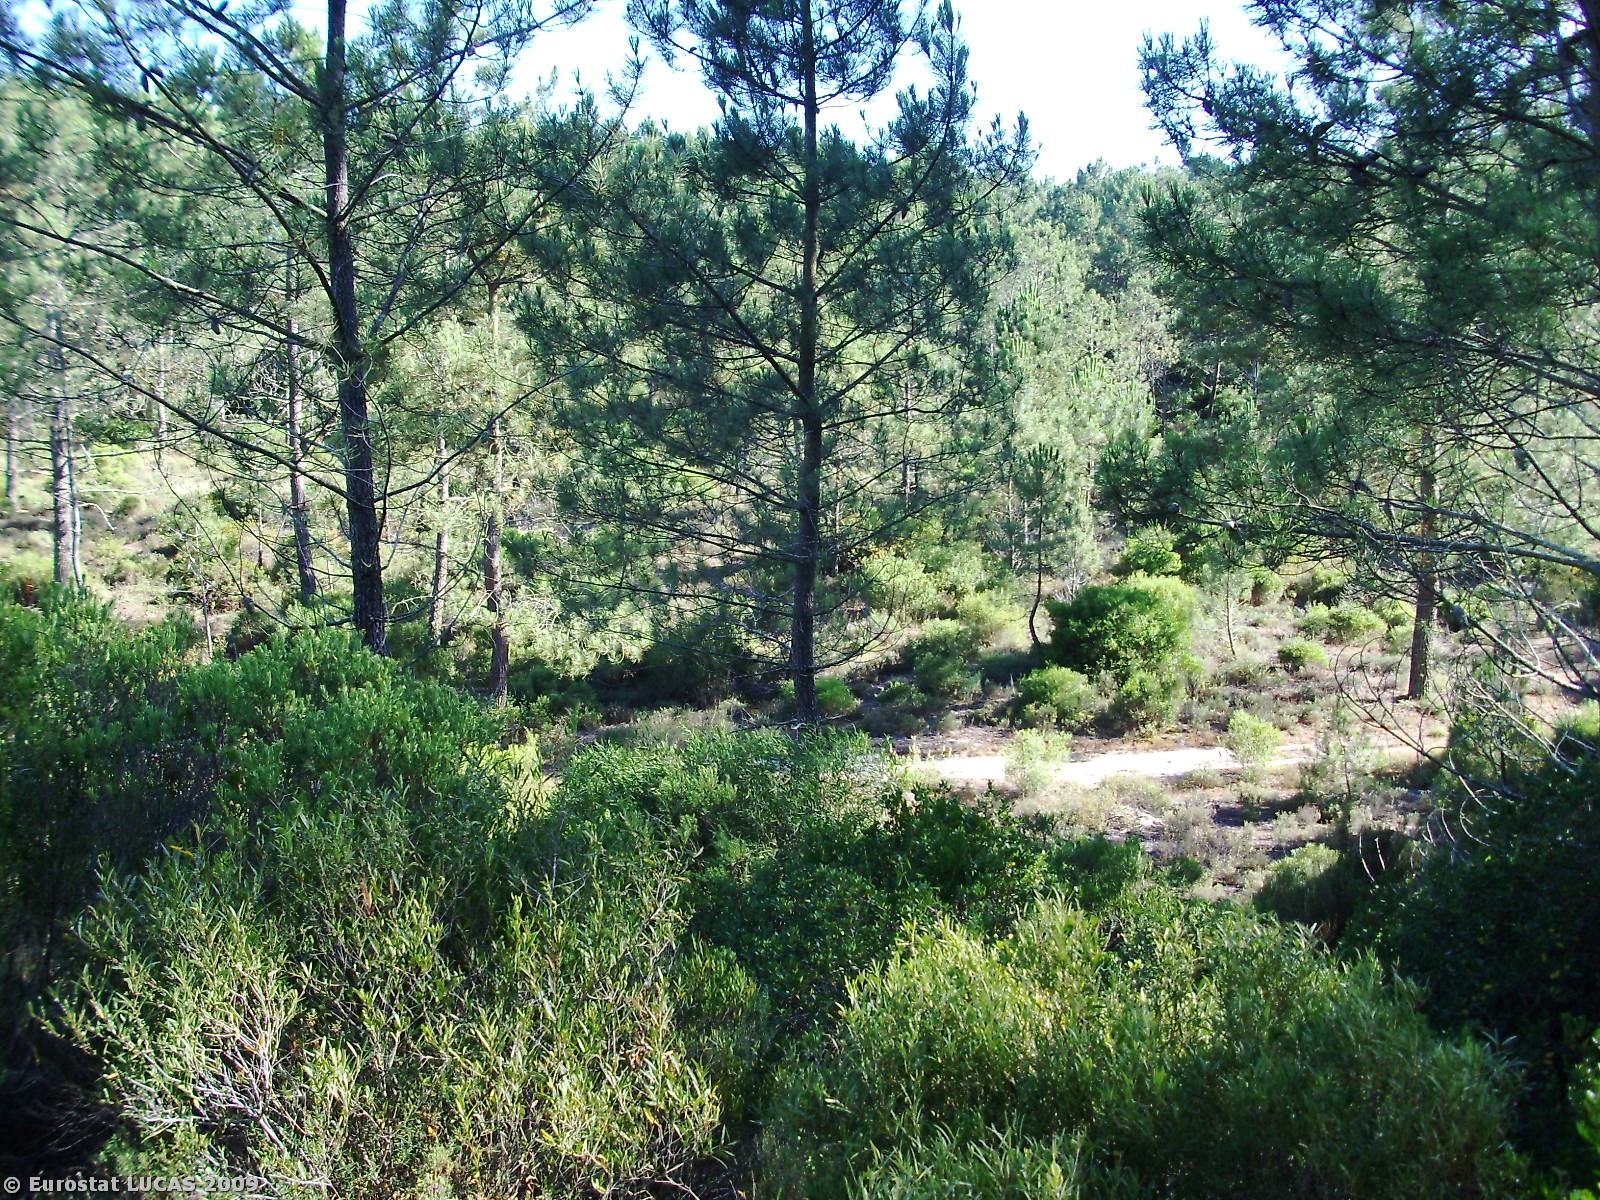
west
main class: Woodland
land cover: Coniferous woodland
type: coniferous forest of the mediterranean region
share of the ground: 50 - 75 %
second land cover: Grassland with sparse tree/shrub cover
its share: 25 - 50 %
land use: Forestry
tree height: > 5 m
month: July
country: PT
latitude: 39.8033
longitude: -8.9783
